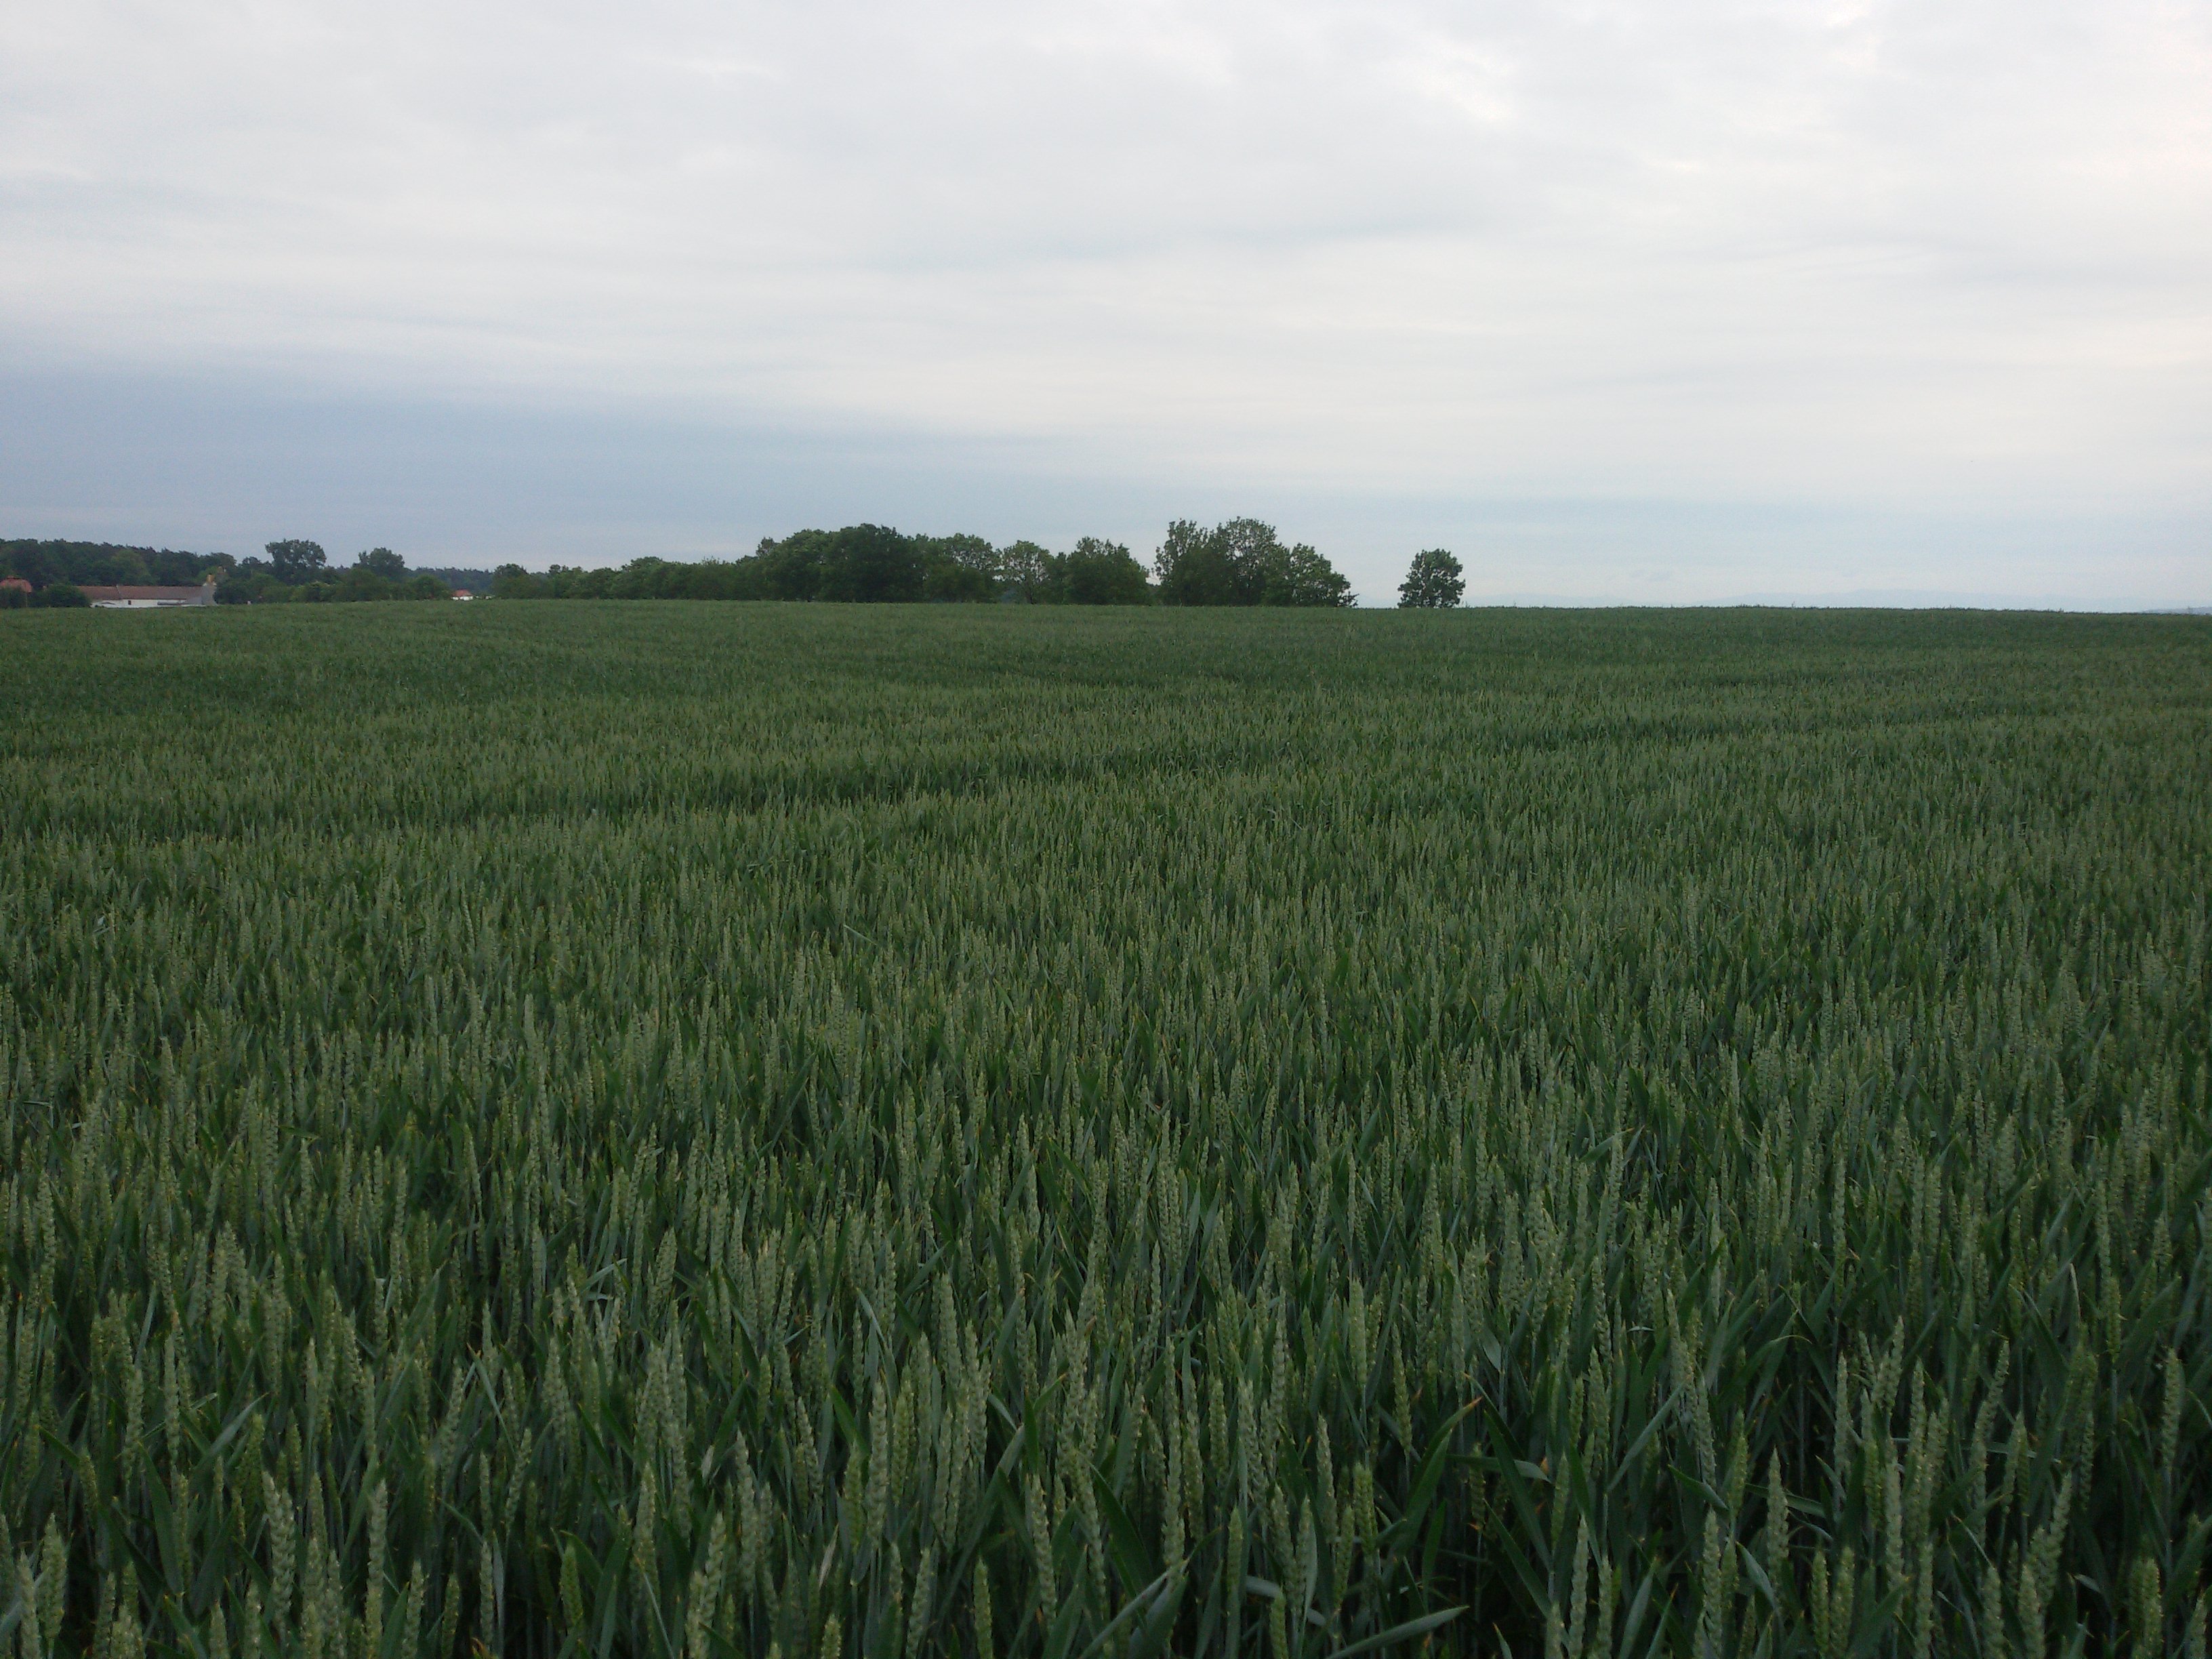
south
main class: Cropland
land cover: Common wheat
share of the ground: > 75 %
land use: Agriculture (excluding fallow land and kitchen gardens)
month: June
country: PL
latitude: 51.2483
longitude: 15.7212
